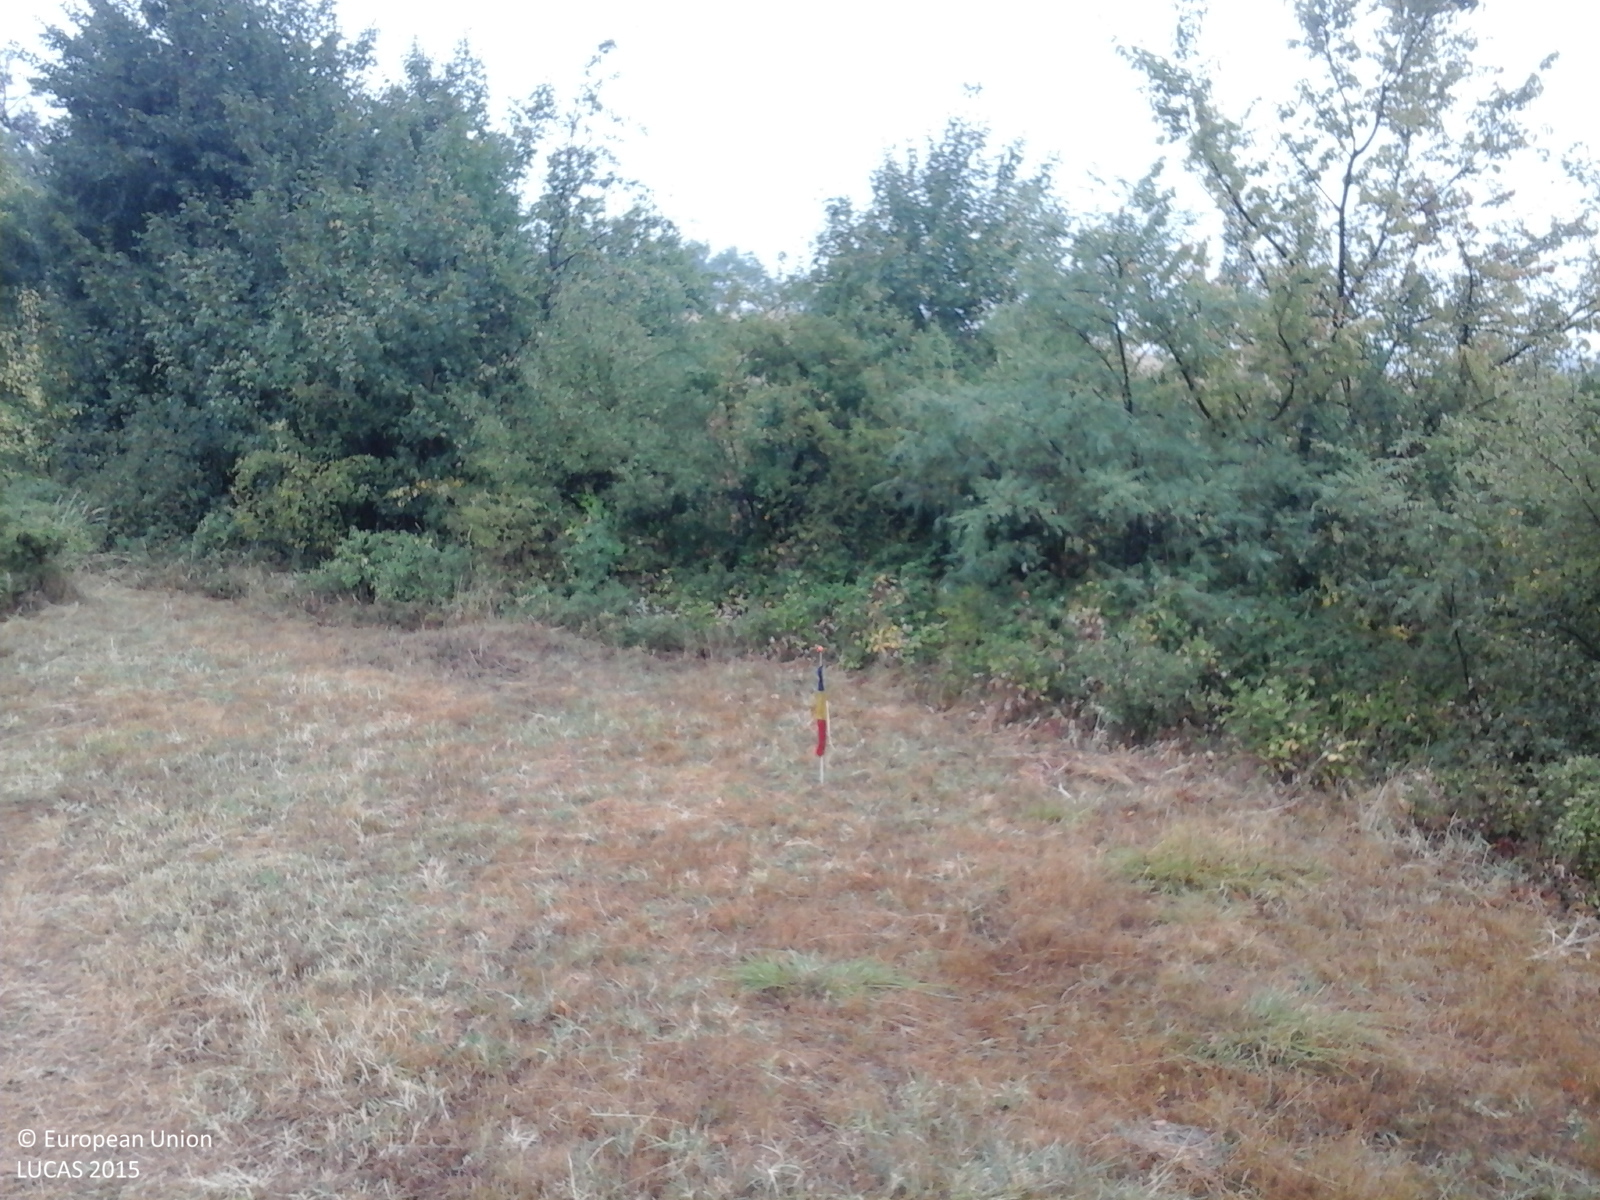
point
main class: Grassland
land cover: Grassland without tree/shrub cover
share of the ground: > 75 %
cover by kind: herbaceous plants 100 %
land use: Agriculture (excluding fallow land and kitchen gardens)
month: August
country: RO
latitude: 44.7891
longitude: 22.6955
